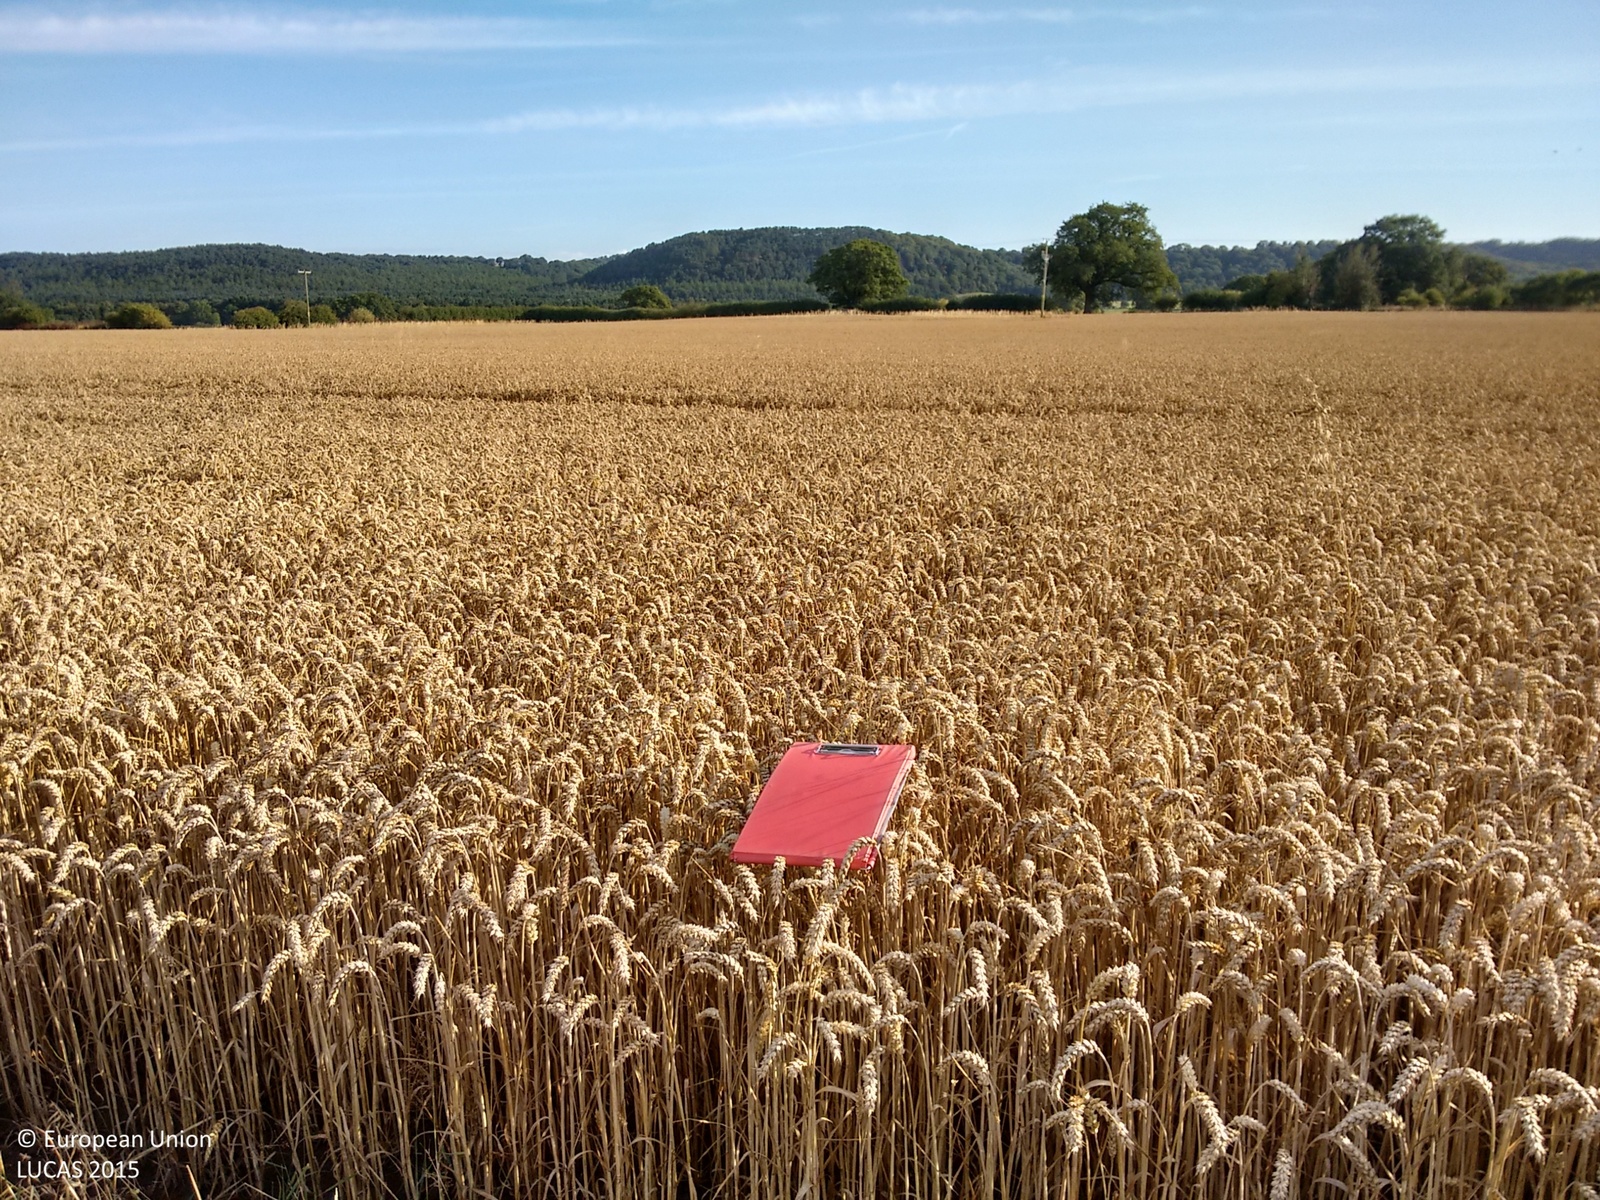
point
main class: Cropland
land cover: Common wheat
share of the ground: > 75 %
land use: Agriculture (excluding fallow land and kitchen gardens)
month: August
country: GB
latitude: 52.8274
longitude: -2.6391
